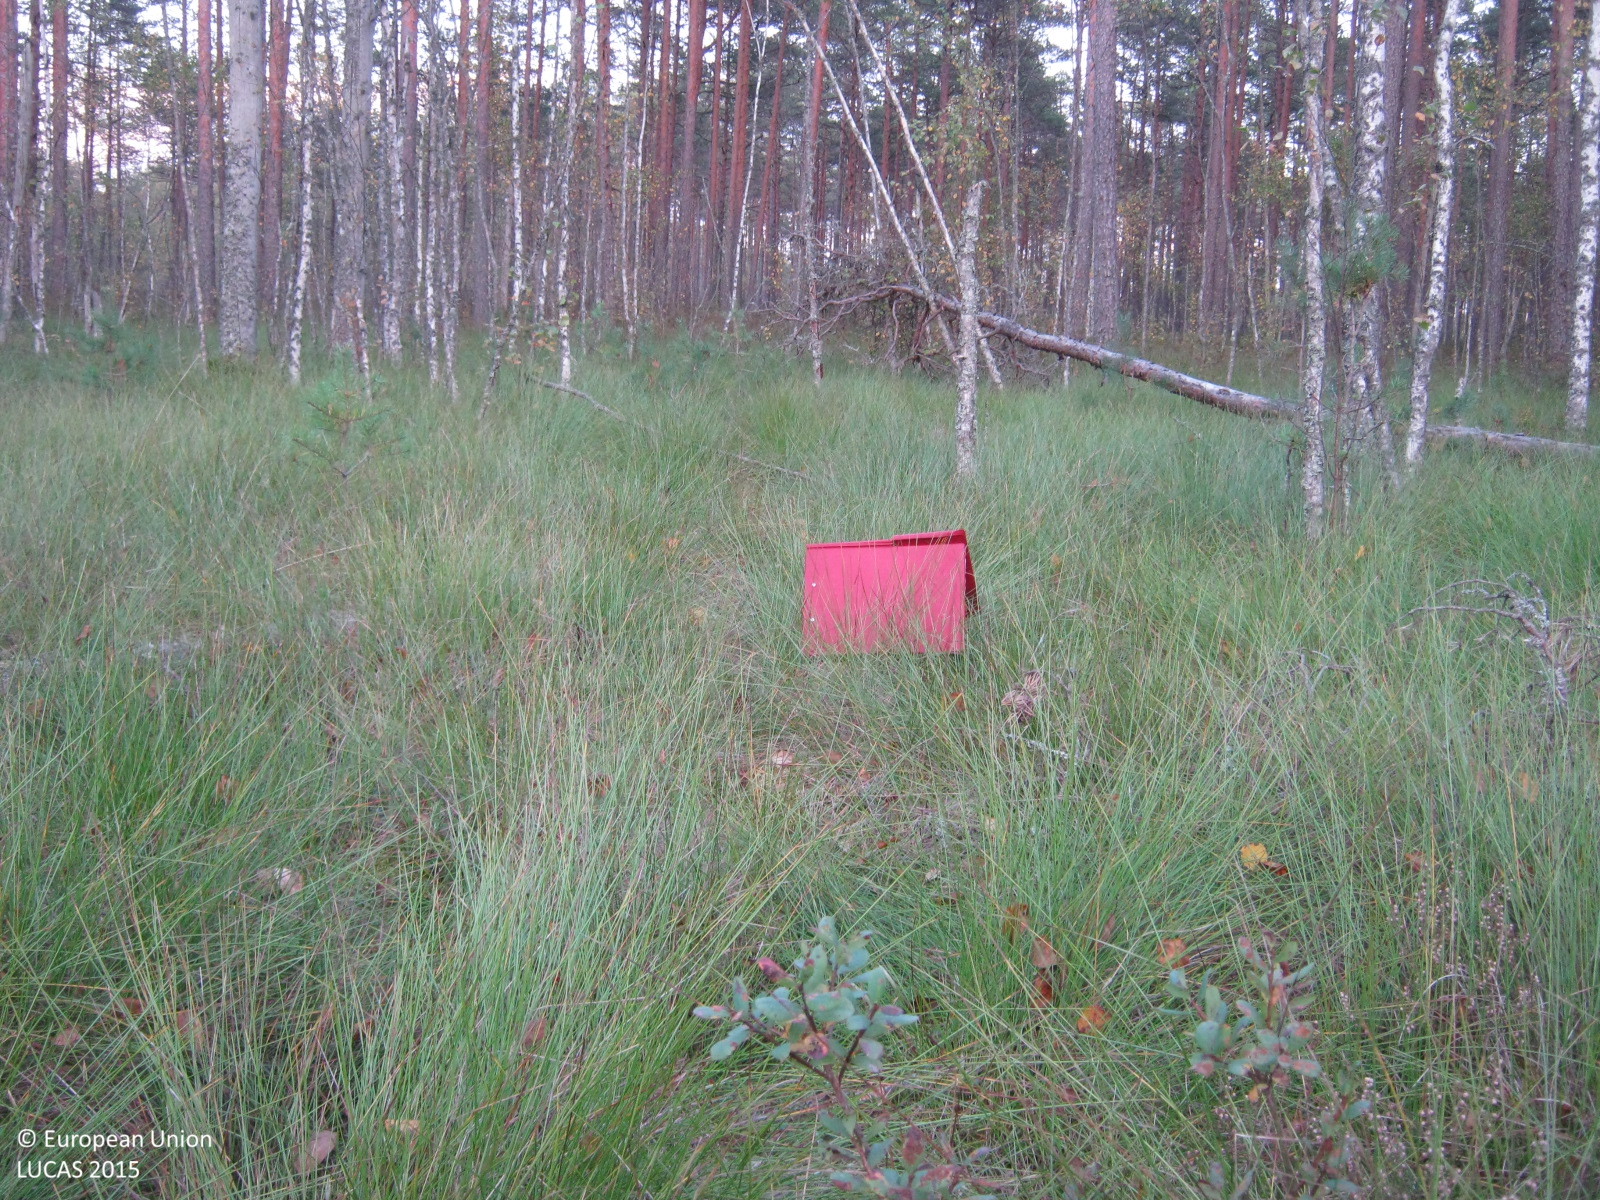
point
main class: Woodland
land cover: Pine dominated mixed woodland
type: hemiboreal forest and nemoral coniferous forest and mixed broadleaved-coniferous forest
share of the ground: > 75 %
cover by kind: coniferous forest trees 45 %, broadleaved forest trees 30 %, herbaceous plants 15 %, lichens and mosses 10 %
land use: Forestry
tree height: > 5 m
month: September
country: LV
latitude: 57.4157
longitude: 24.7652
